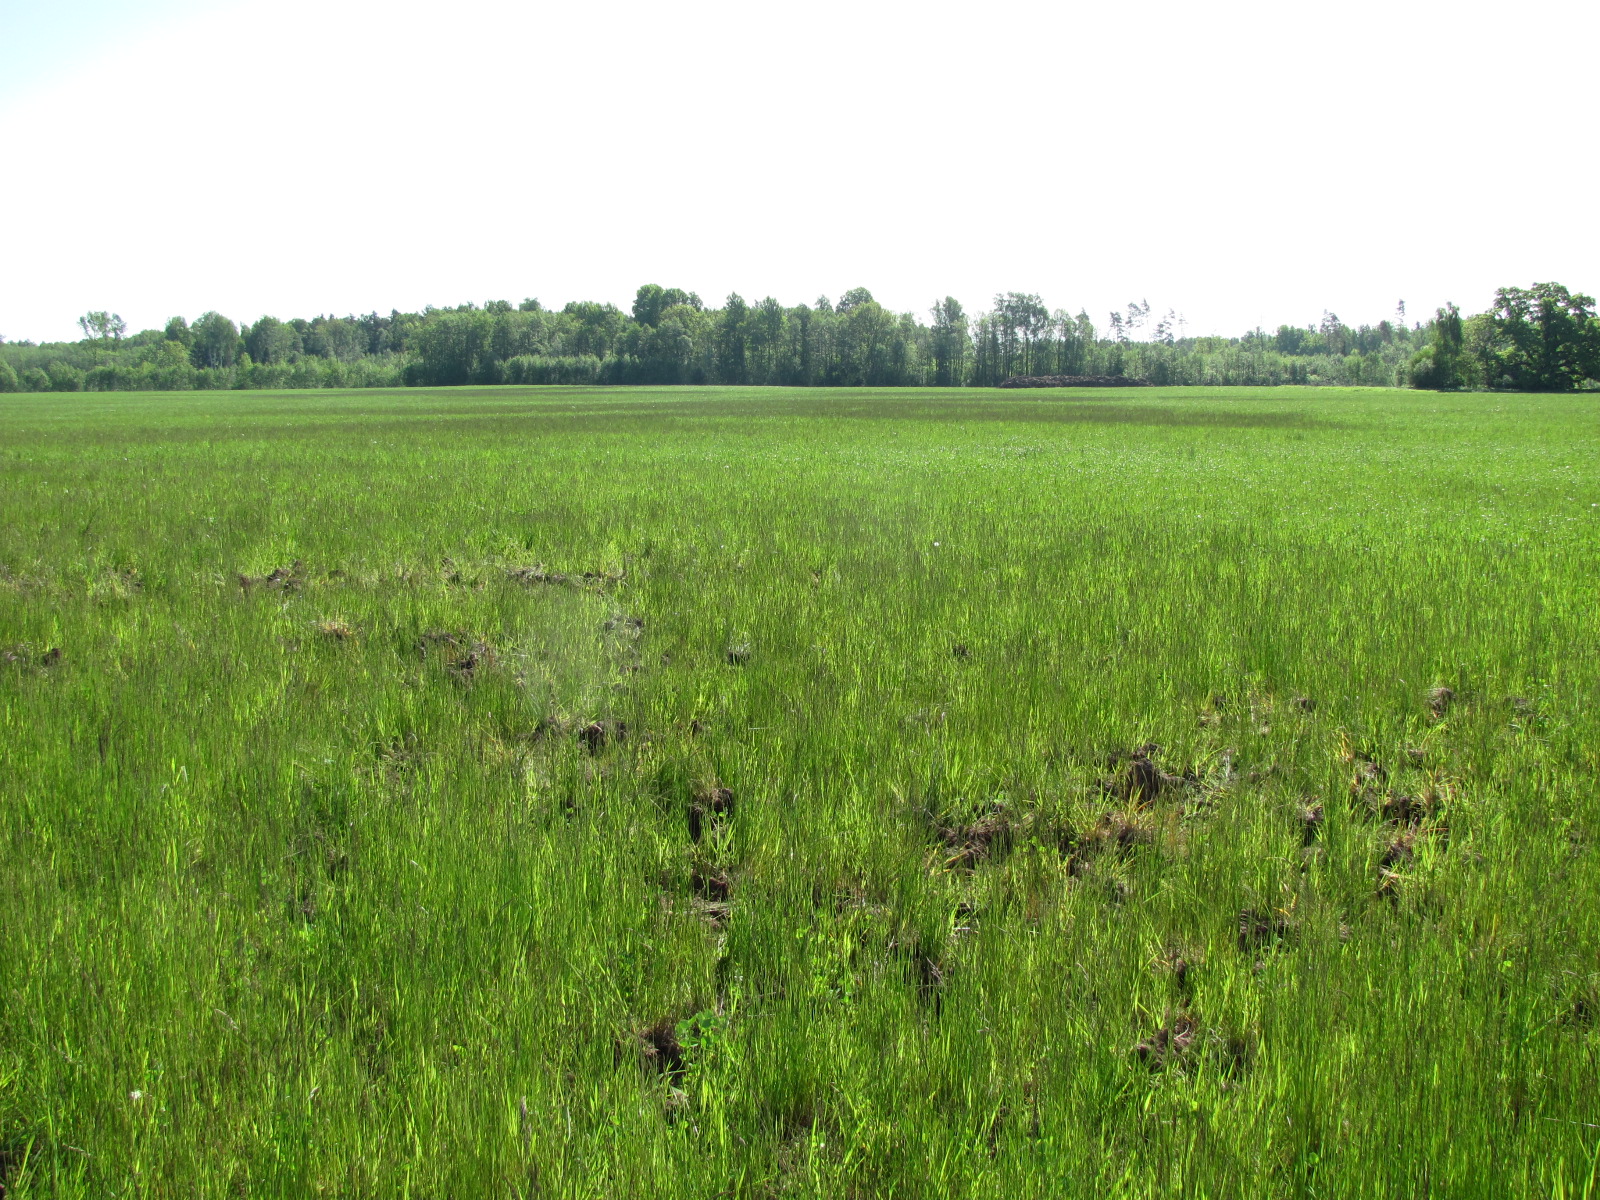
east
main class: Grassland
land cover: Grassland without tree/shrub cover
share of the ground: > 75 %
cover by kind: herbaceous plants 100 %
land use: Agriculture (excluding fallow land and kitchen gardens)
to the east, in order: Grassland without tree/shrub cover
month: May
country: LV
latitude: 56.5600
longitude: 24.0630
